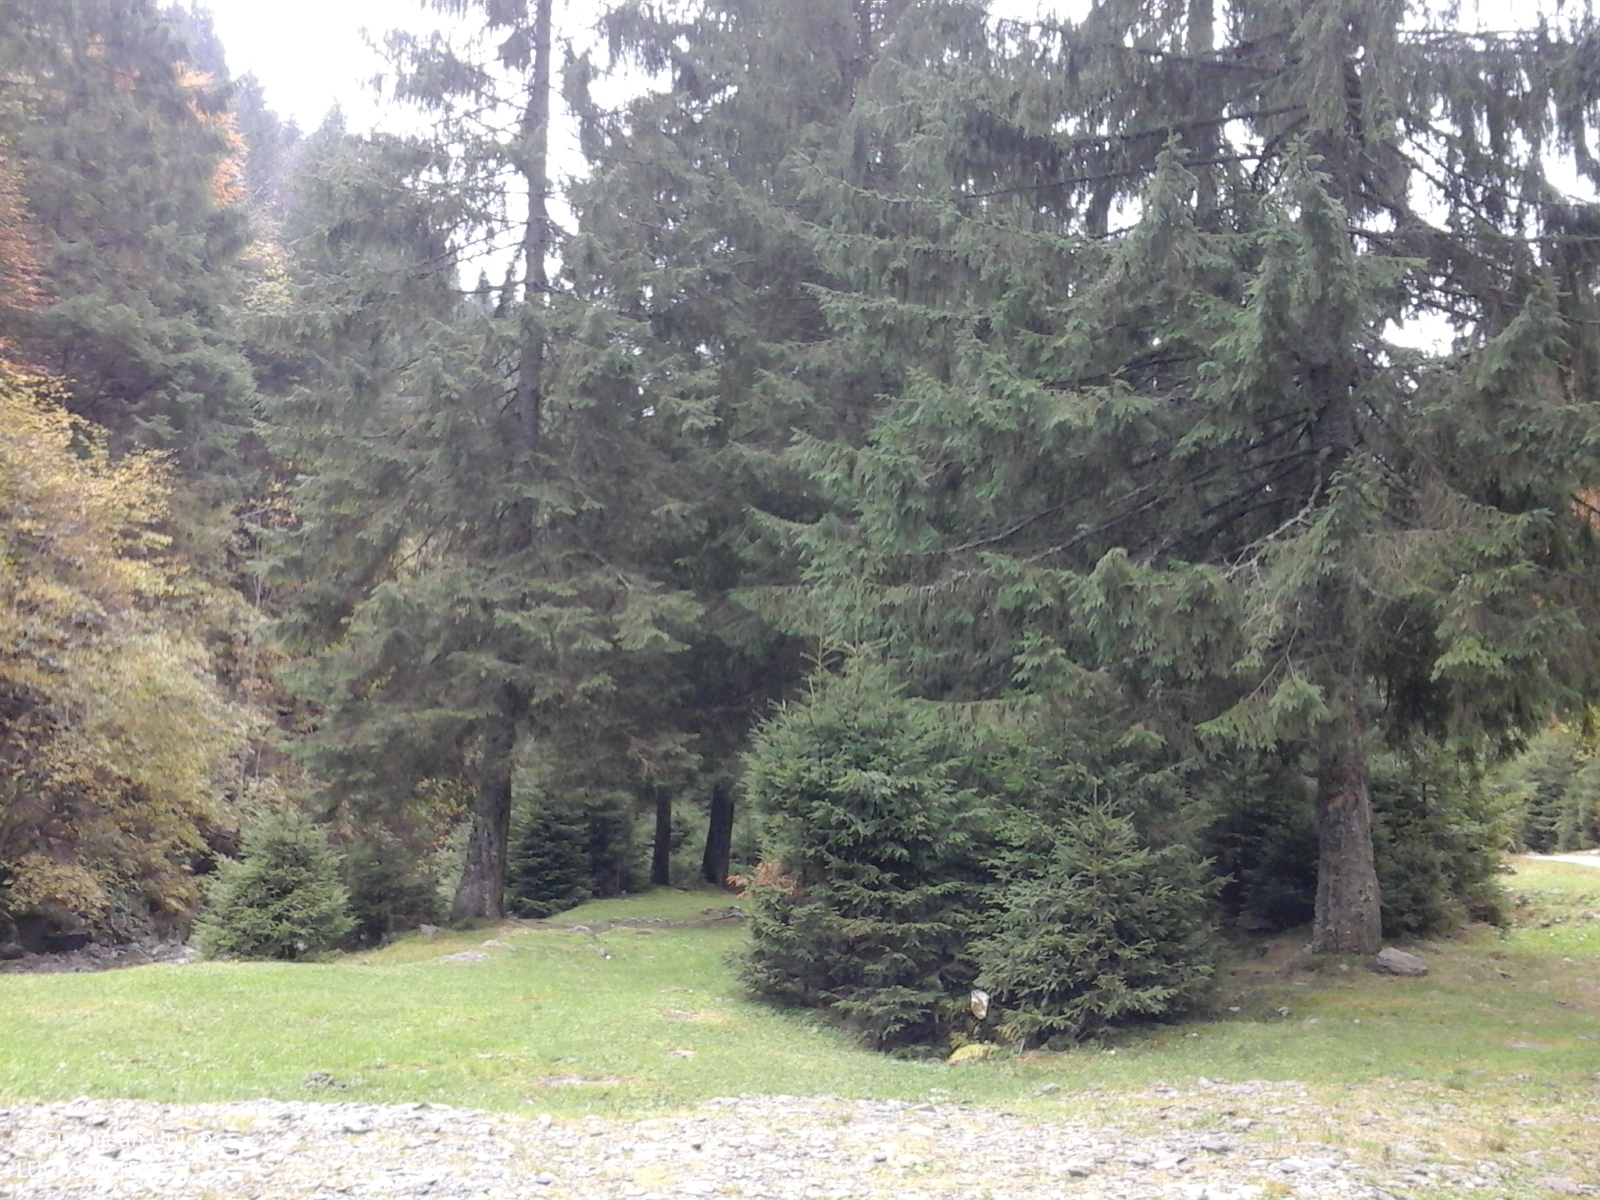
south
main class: Grassland
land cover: Grassland without tree/shrub cover
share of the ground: 50 - 75 %
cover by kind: herbaceous plants 75 %
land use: Agriculture (excluding fallow land and kitchen gardens)
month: October
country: RO
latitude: 45.4631
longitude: 25.0411
